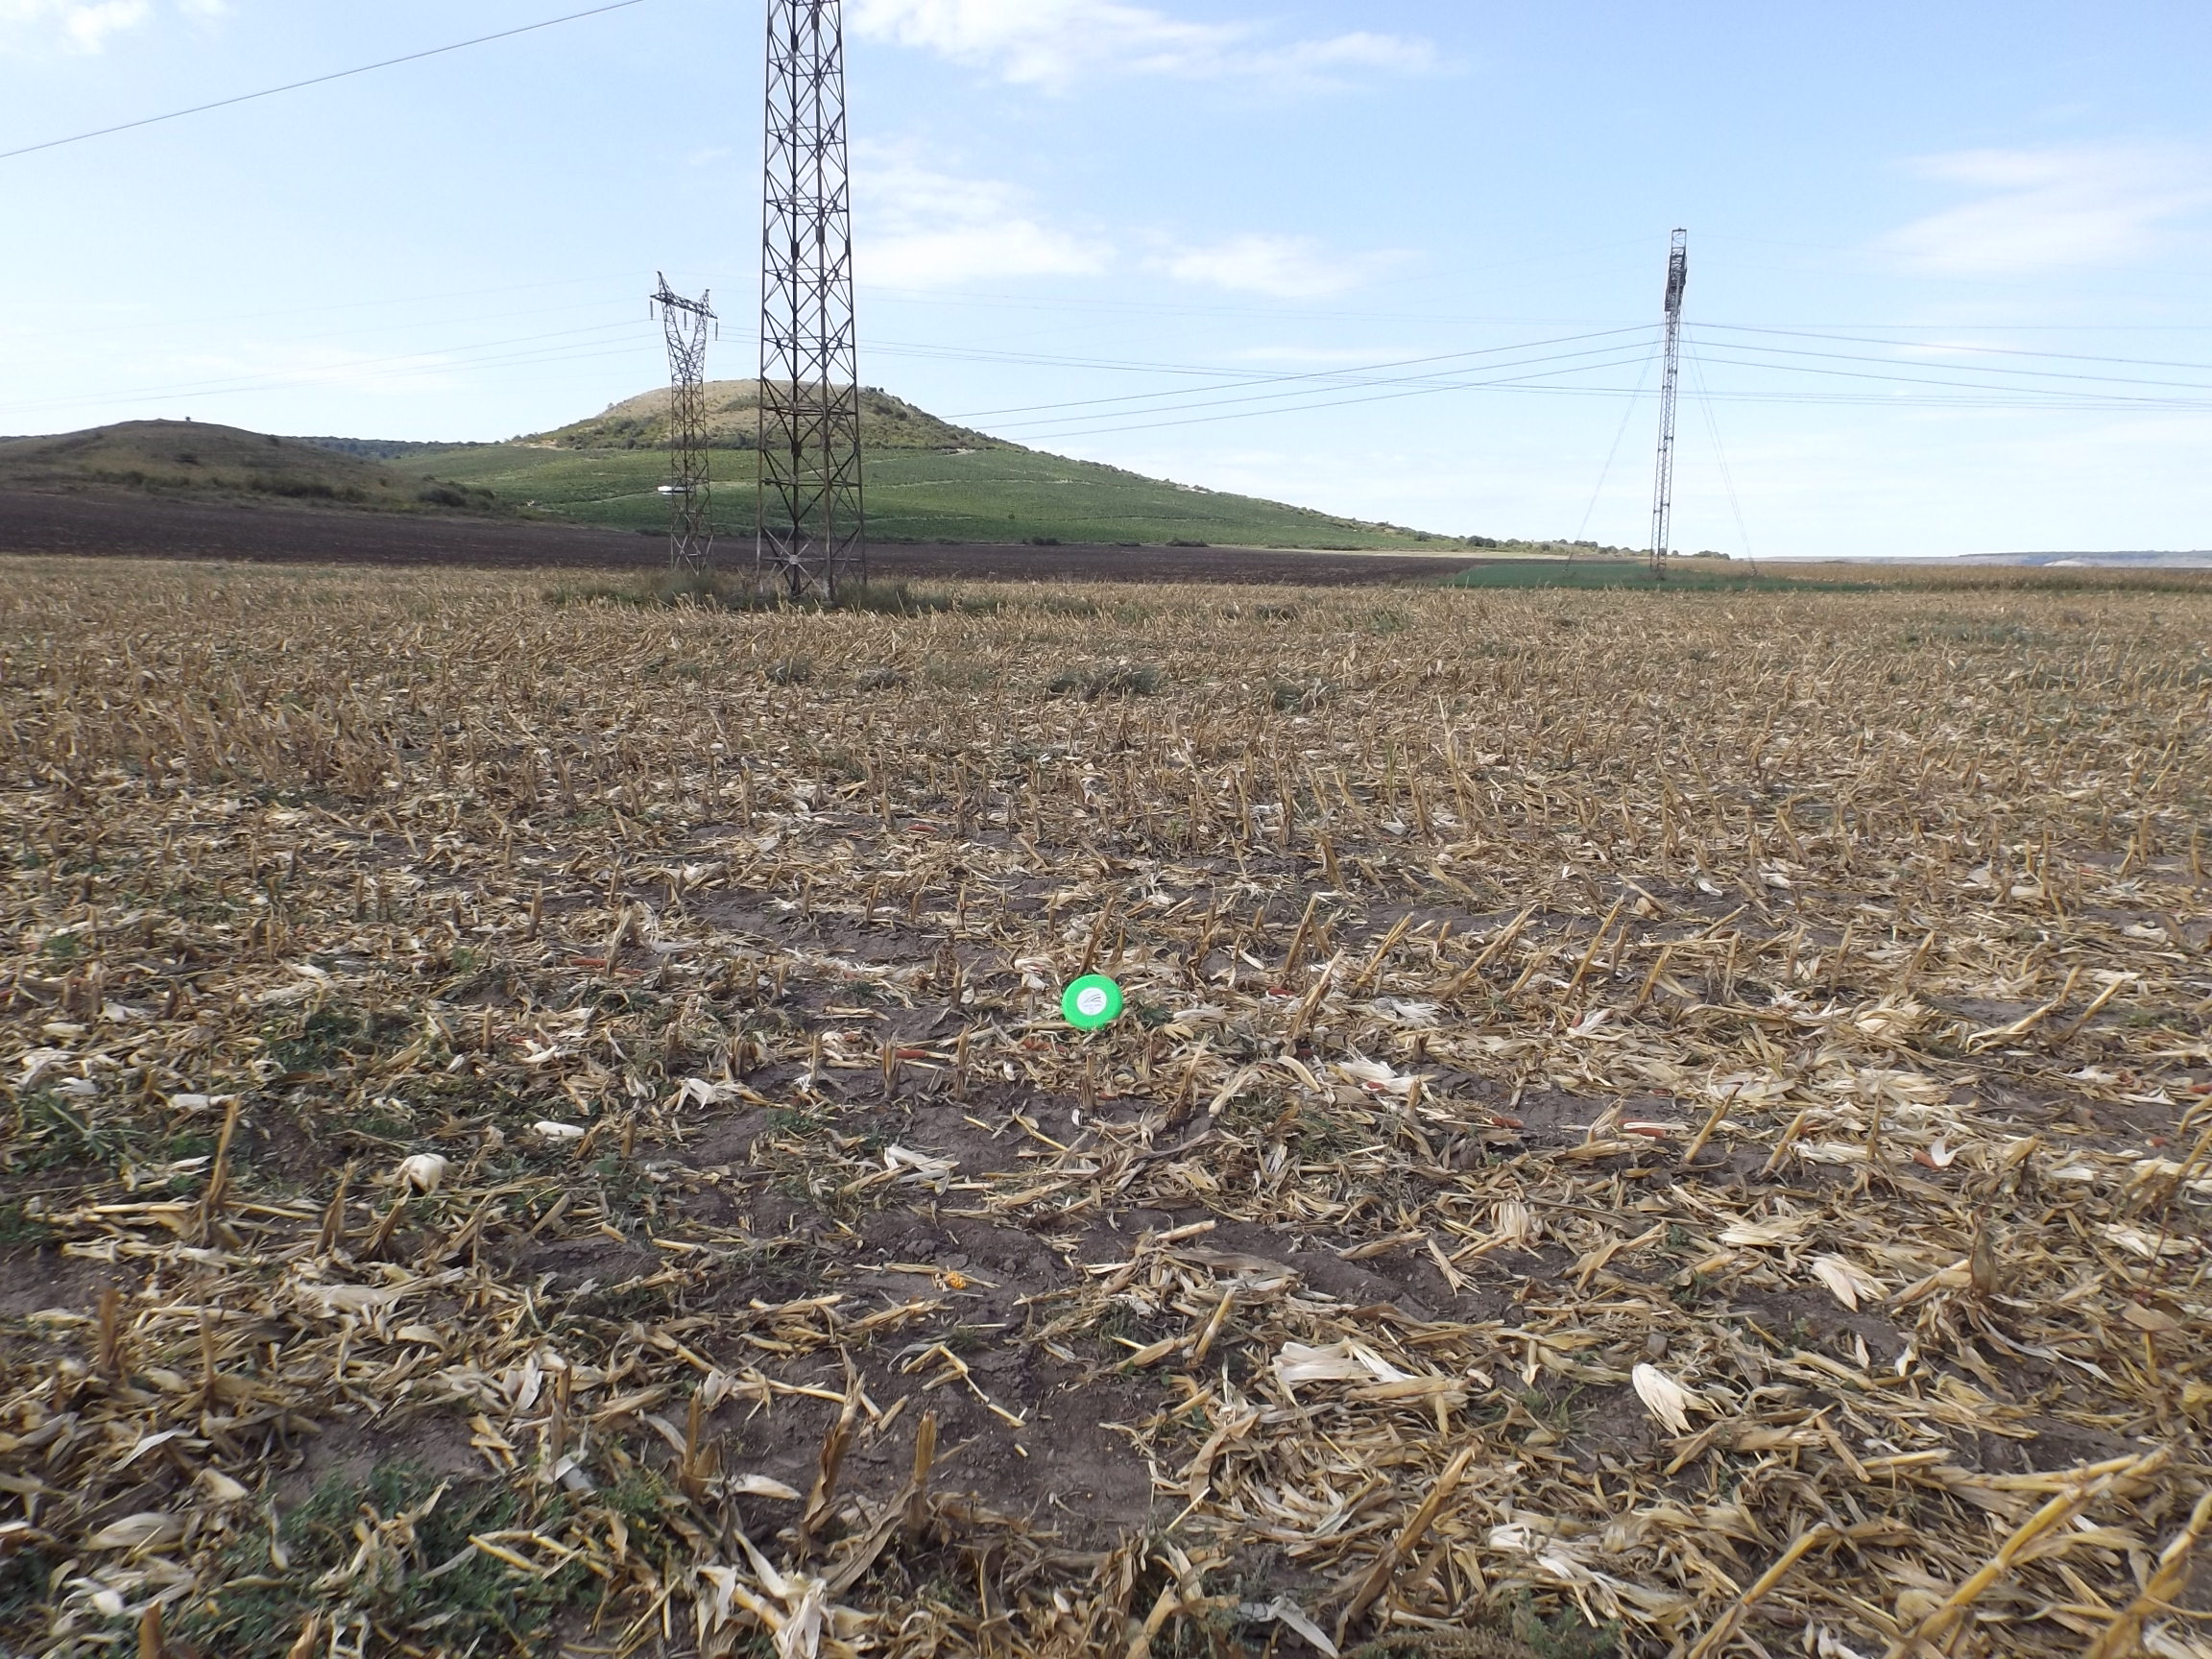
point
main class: Cropland
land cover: Maize
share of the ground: < 10 %
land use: Agriculture (excluding fallow land and kitchen gardens)
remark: Harvested field
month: September
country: BG
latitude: 43.3214
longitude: 27.3260
